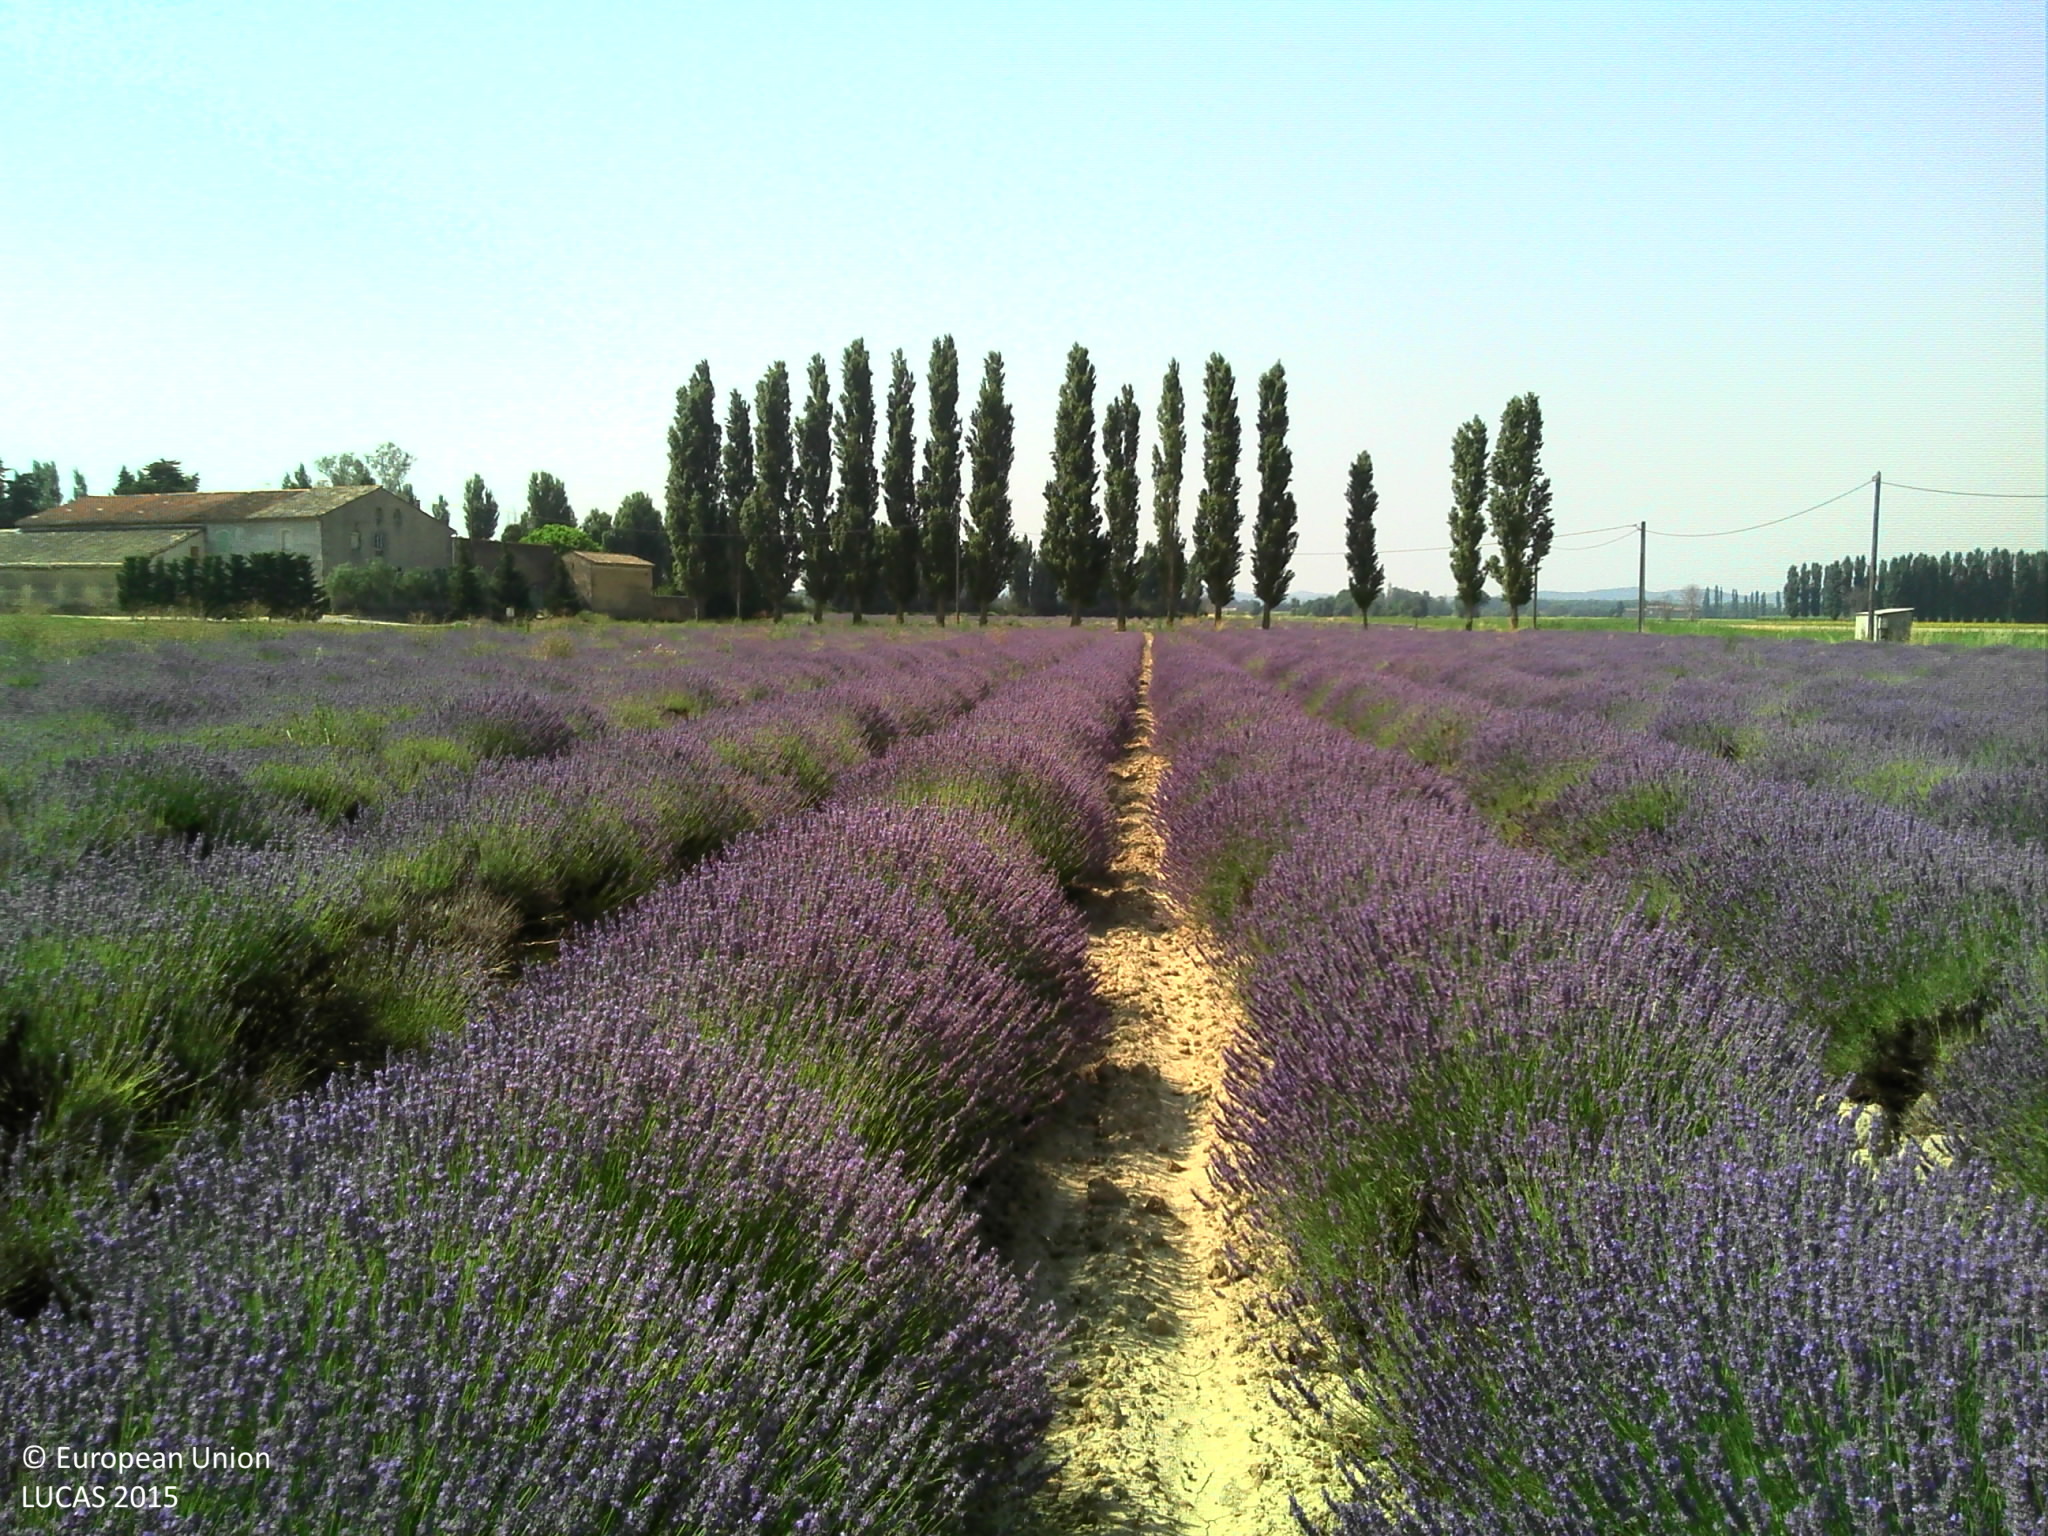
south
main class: Cropland
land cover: Permanent industrial crops
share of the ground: > 75 %
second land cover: Other bare soil
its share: > 75 %
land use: Agriculture (excluding fallow land and kitchen gardens)
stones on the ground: < 10 %
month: July
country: FR
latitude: 44.2865
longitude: 4.6817
